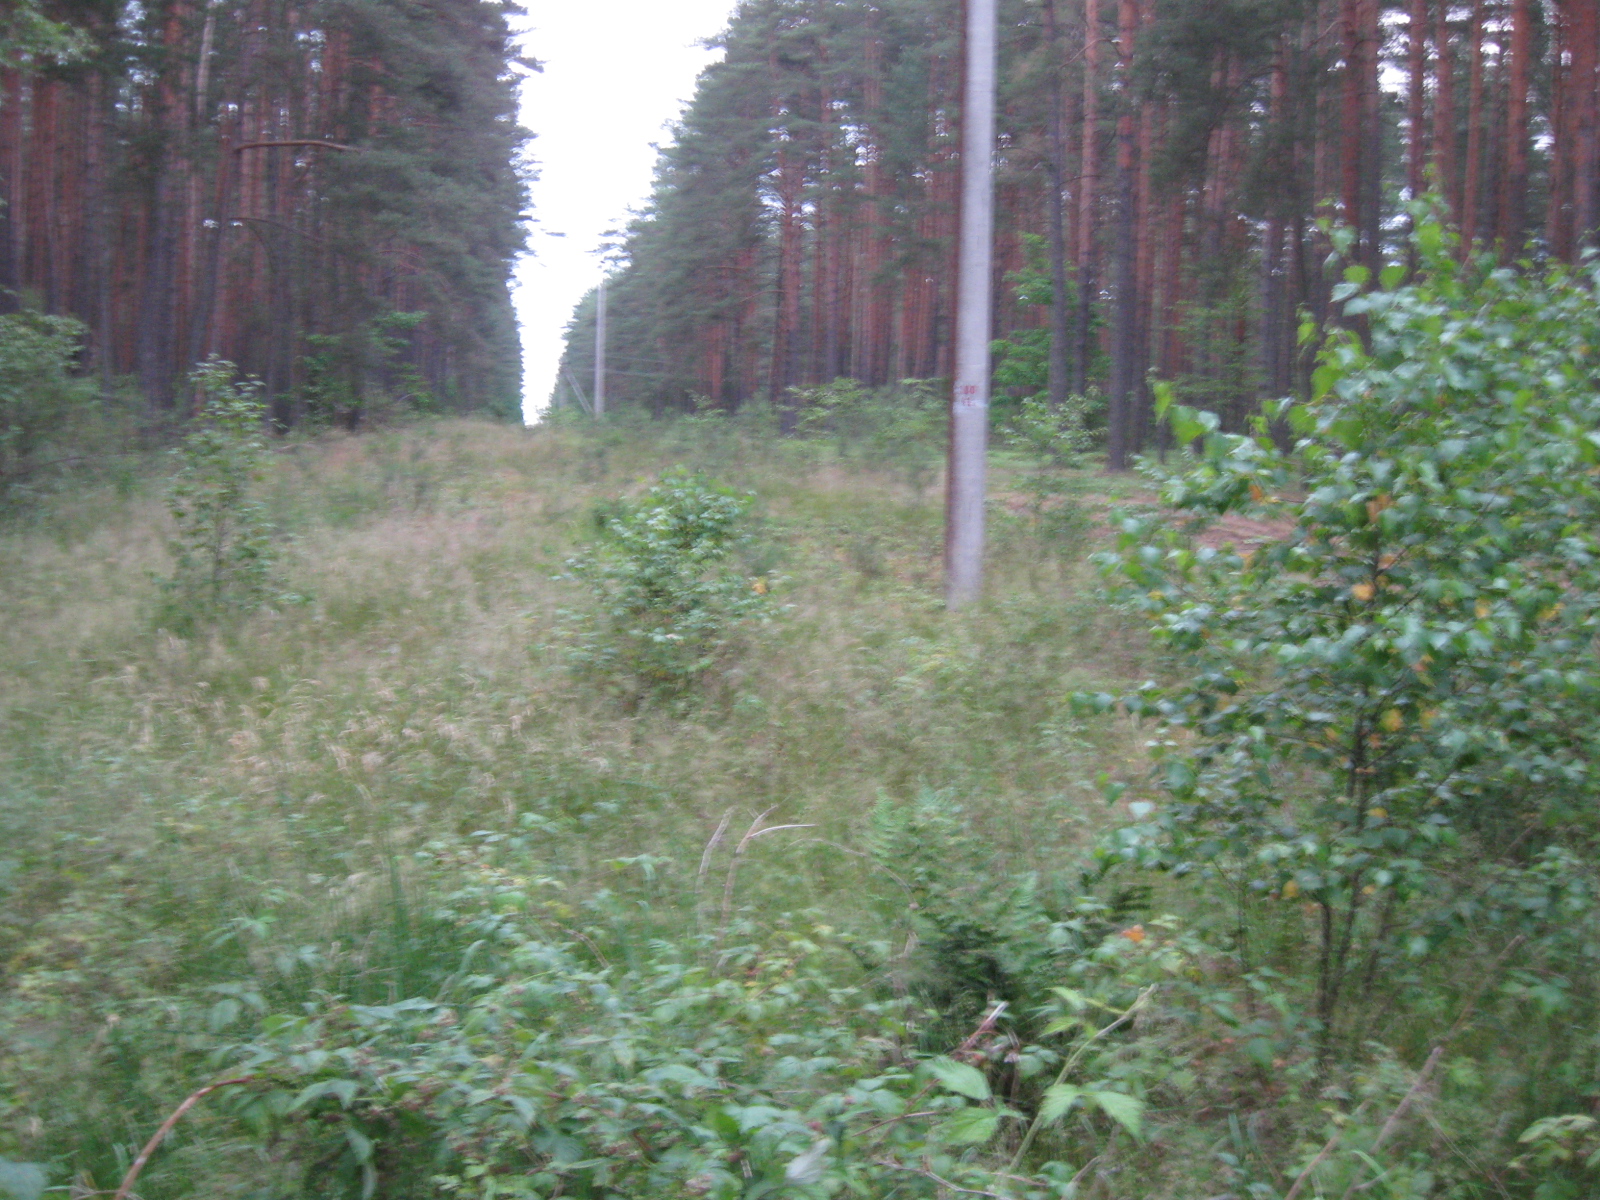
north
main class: Shrubland
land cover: Shrubland with sparse tree cover
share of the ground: > 75 %
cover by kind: shrubs 80 %, herbaceous plants 15 %, broadleaved forest trees 5 %
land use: Electricity, gas and thermal power distribution
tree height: < 5 m
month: June
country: LT
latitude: 54.1494
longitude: 24.1980
